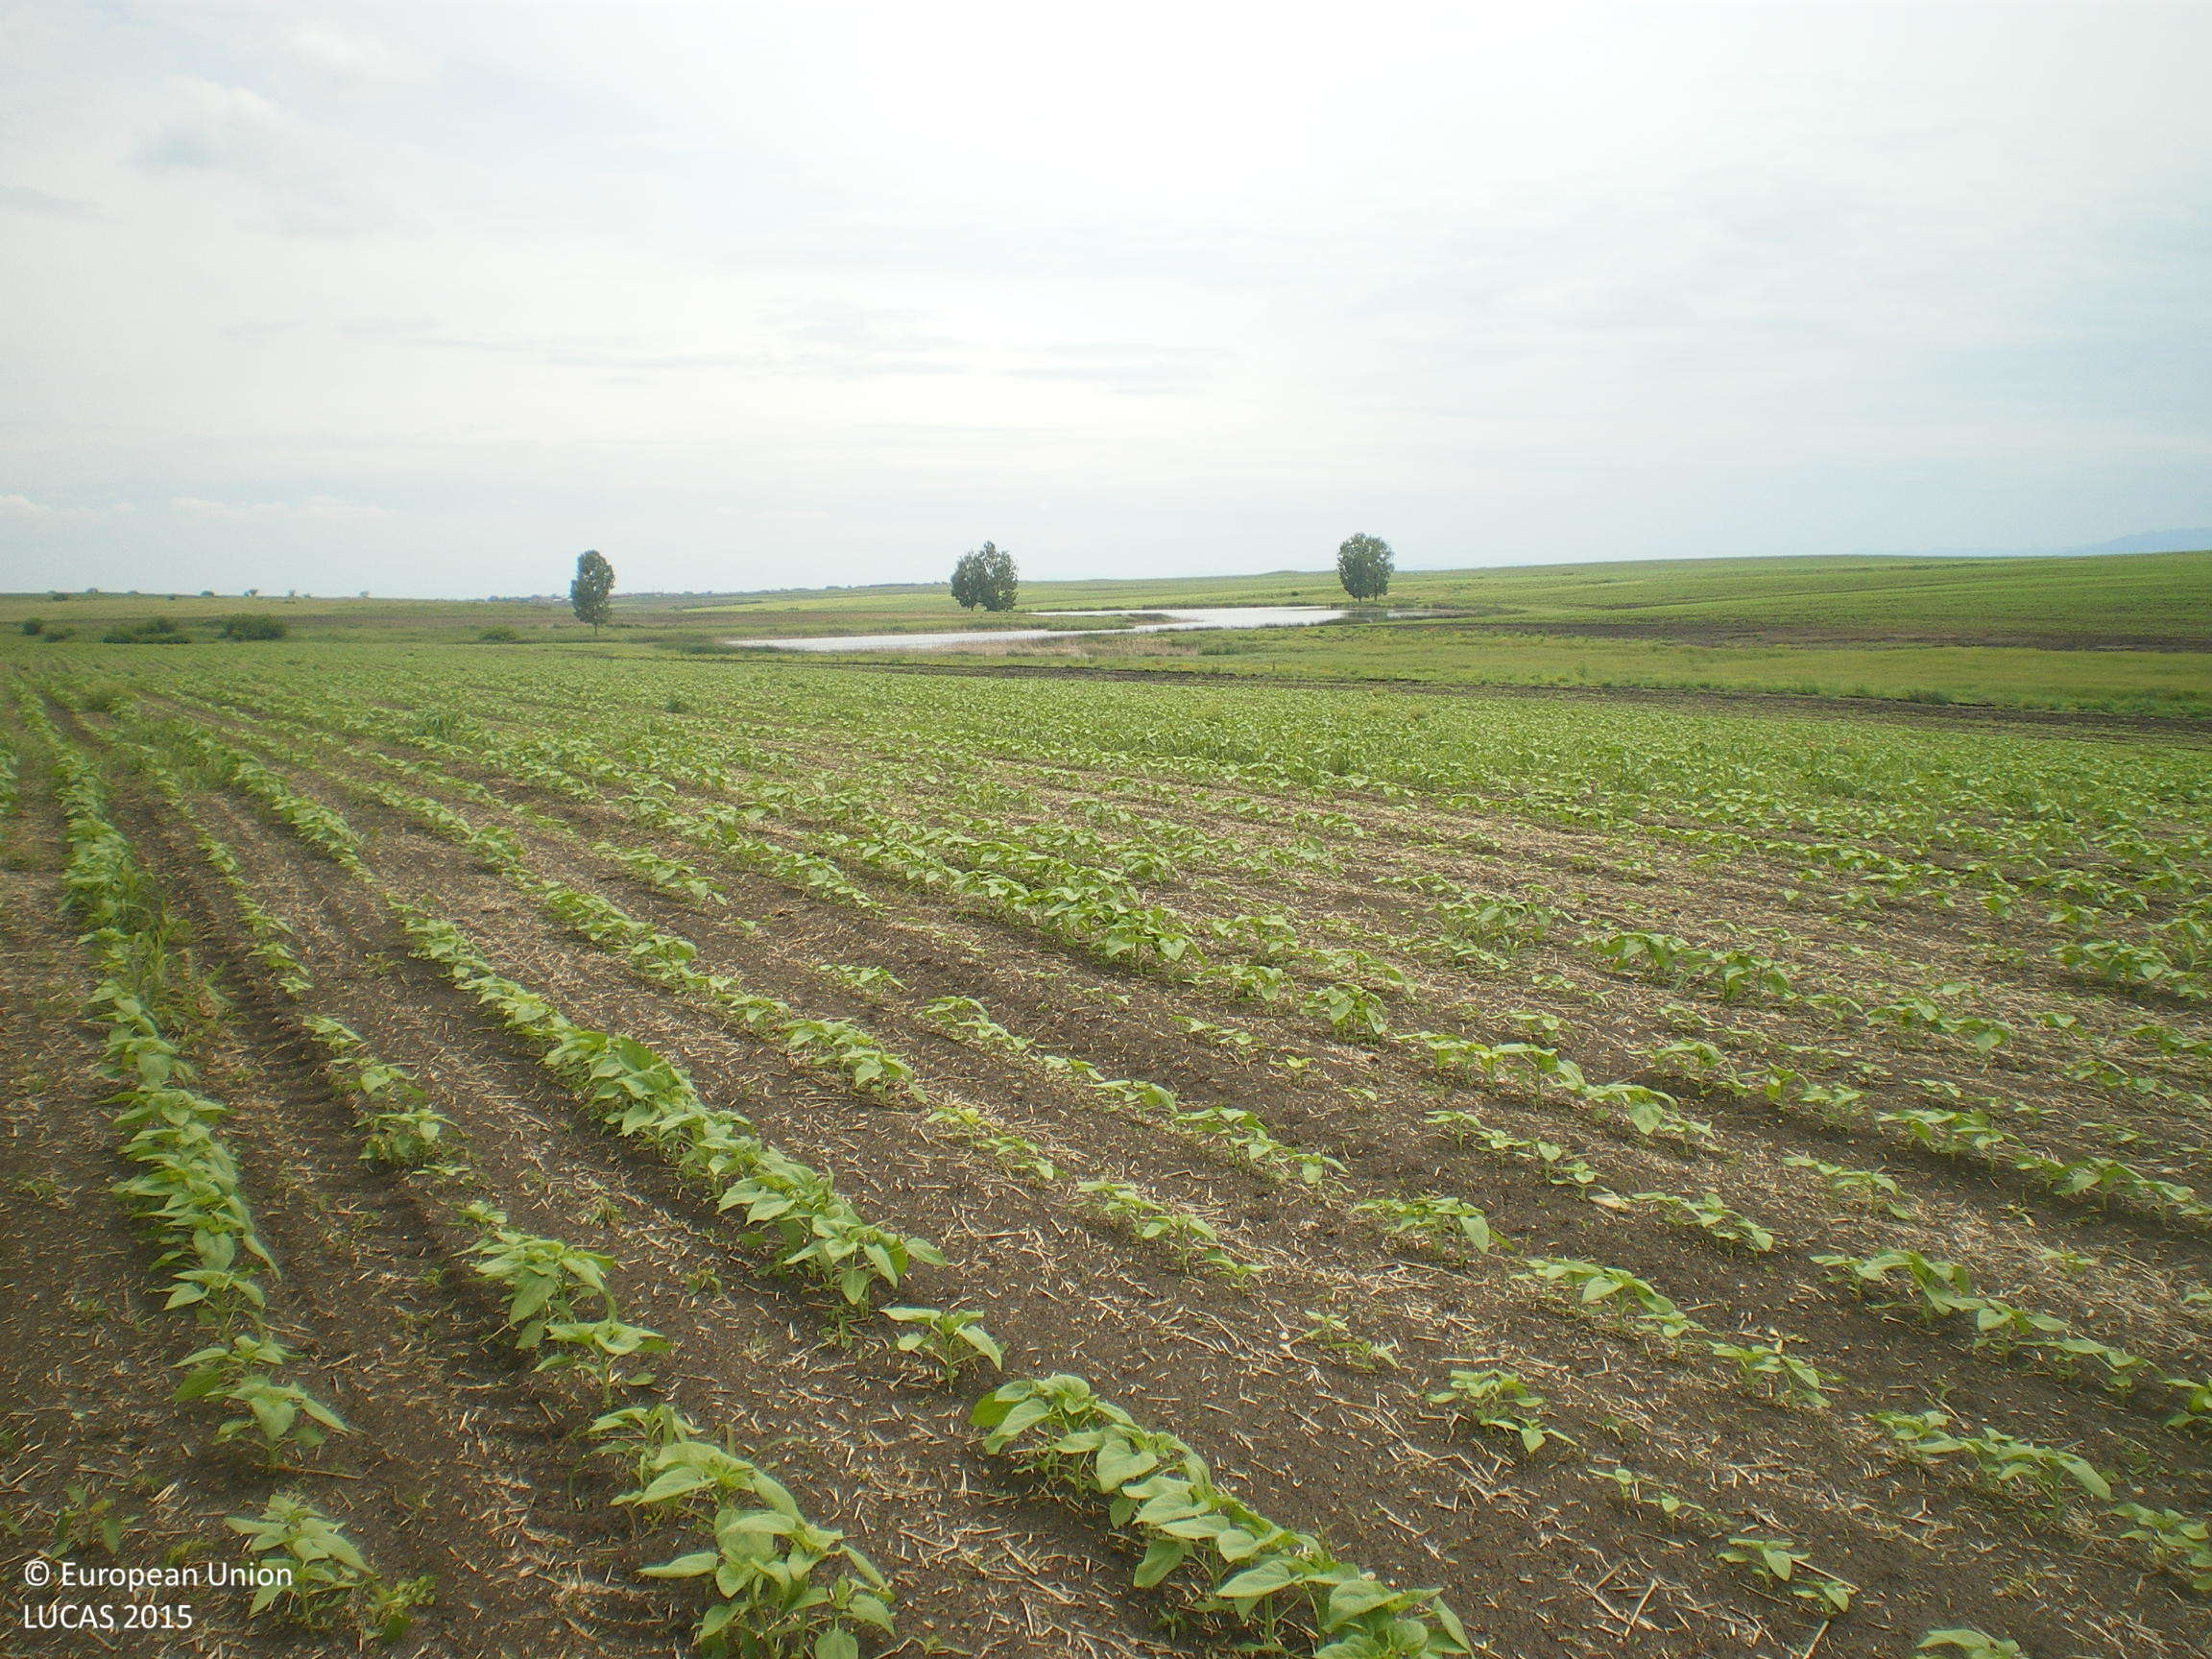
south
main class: Cropland
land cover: Sunflower
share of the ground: 10 - 25 %
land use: Agriculture (excluding fallow land and kitchen gardens)
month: May
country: BG
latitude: 42.2323
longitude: 25.4421
